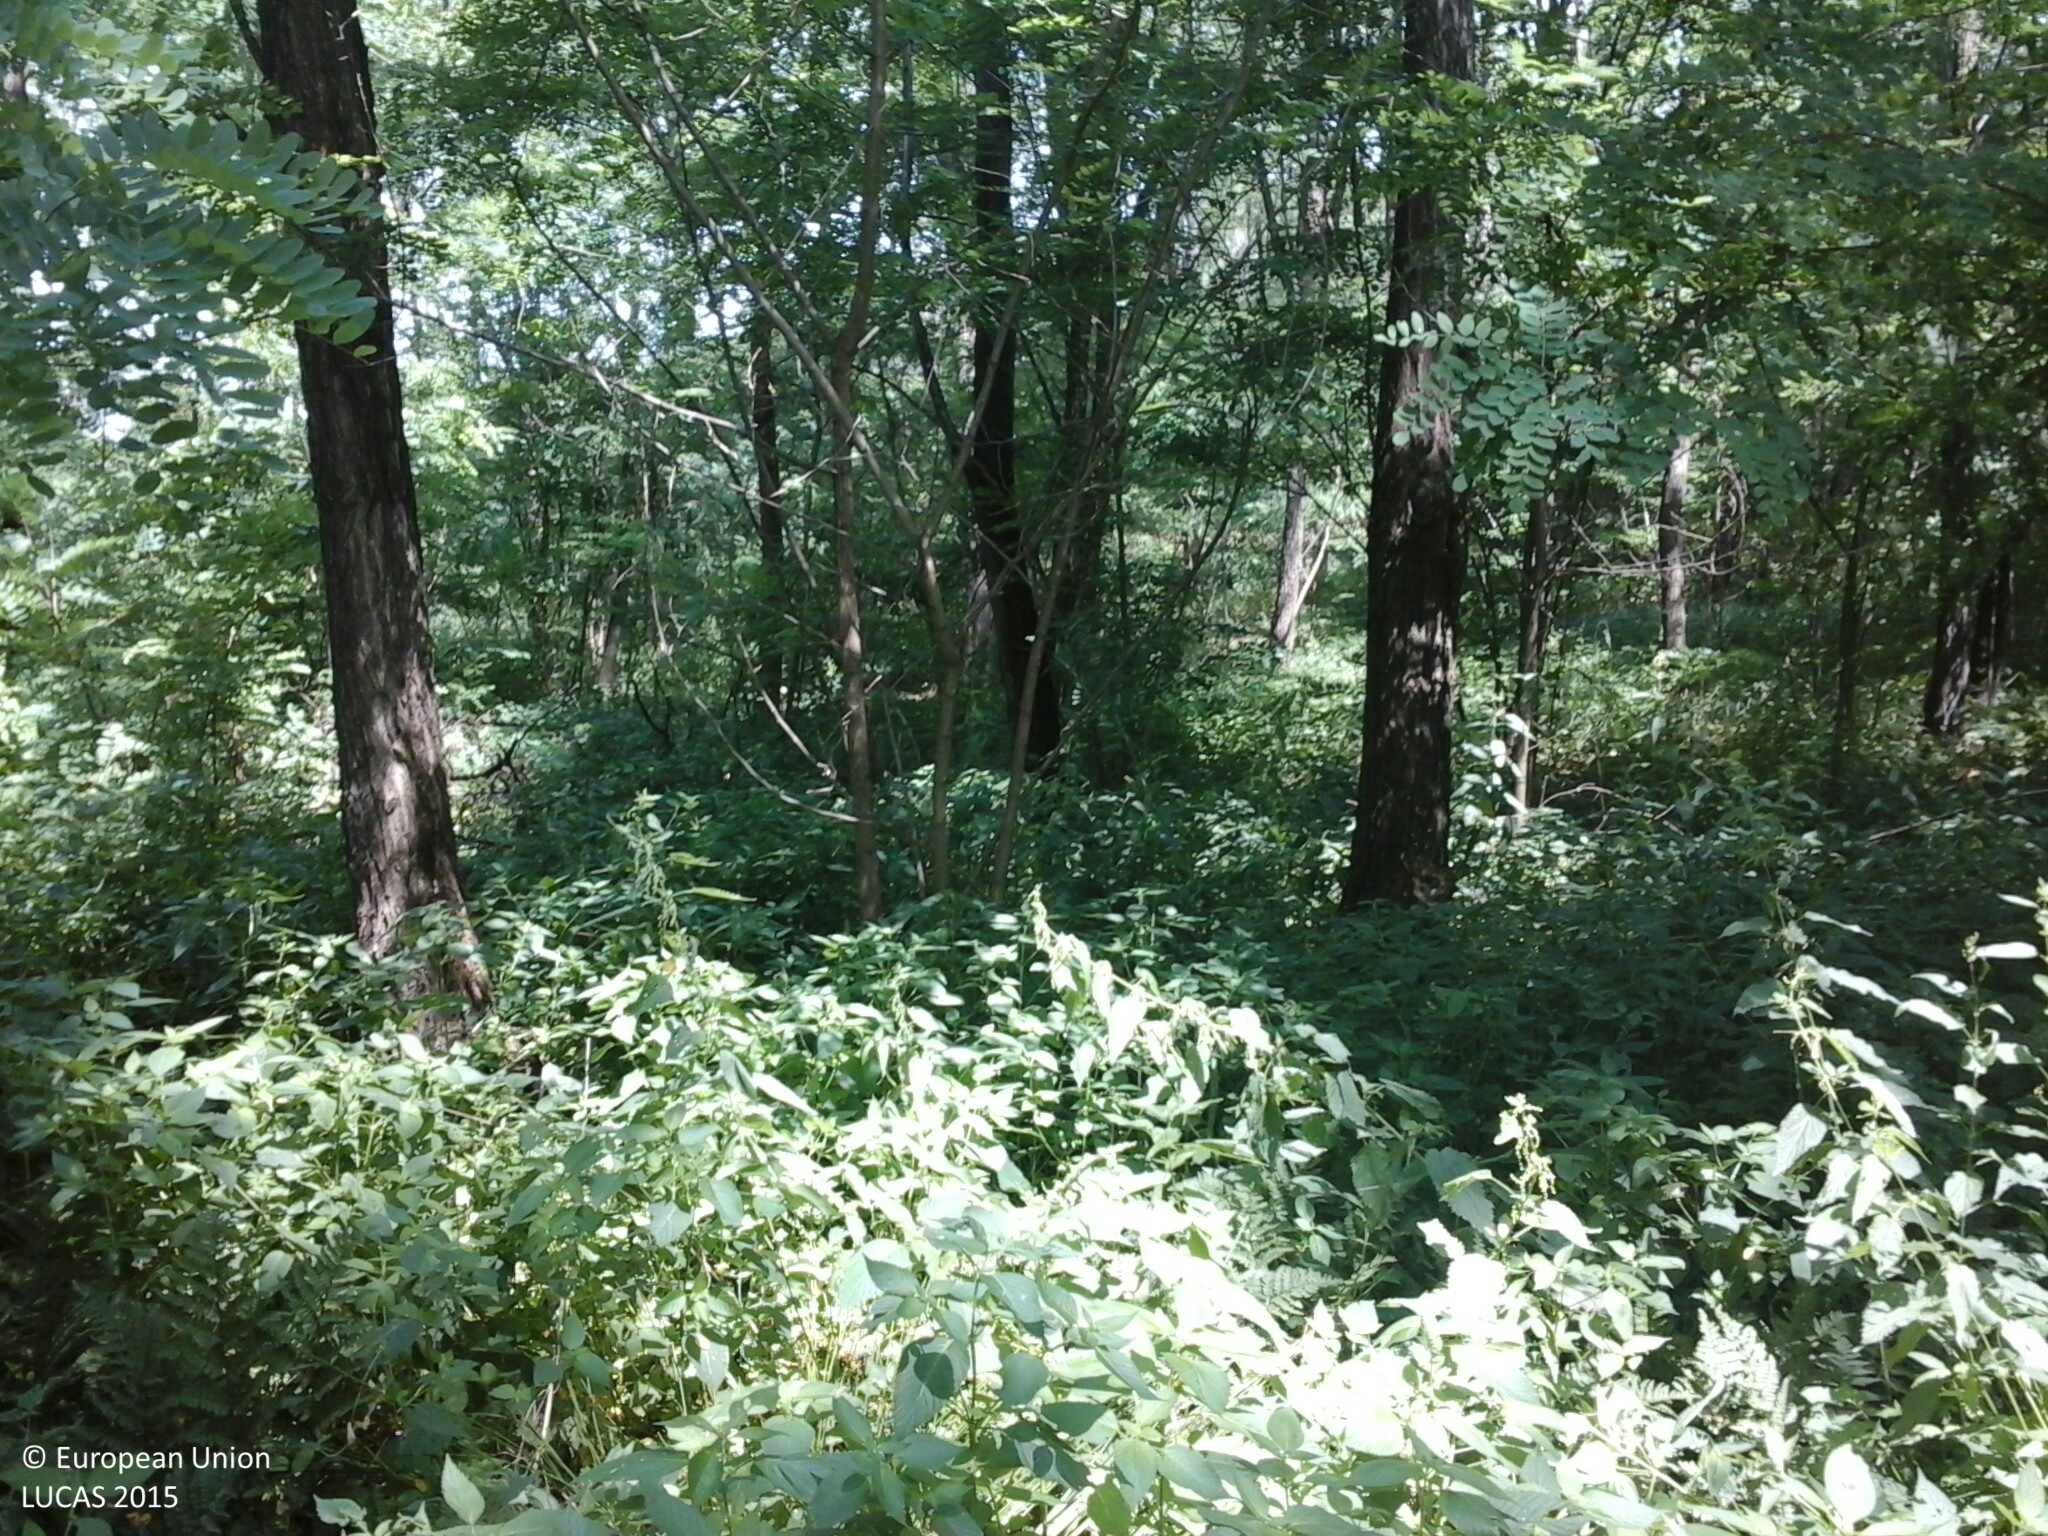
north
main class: Woodland
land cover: Broadleaved woodland
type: mesophytic deciduous forest
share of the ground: > 75 %
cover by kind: broadleaved forest trees 100 %
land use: Forestry
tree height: > 5 m
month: July
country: HU
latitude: 48.3068
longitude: 22.2041
